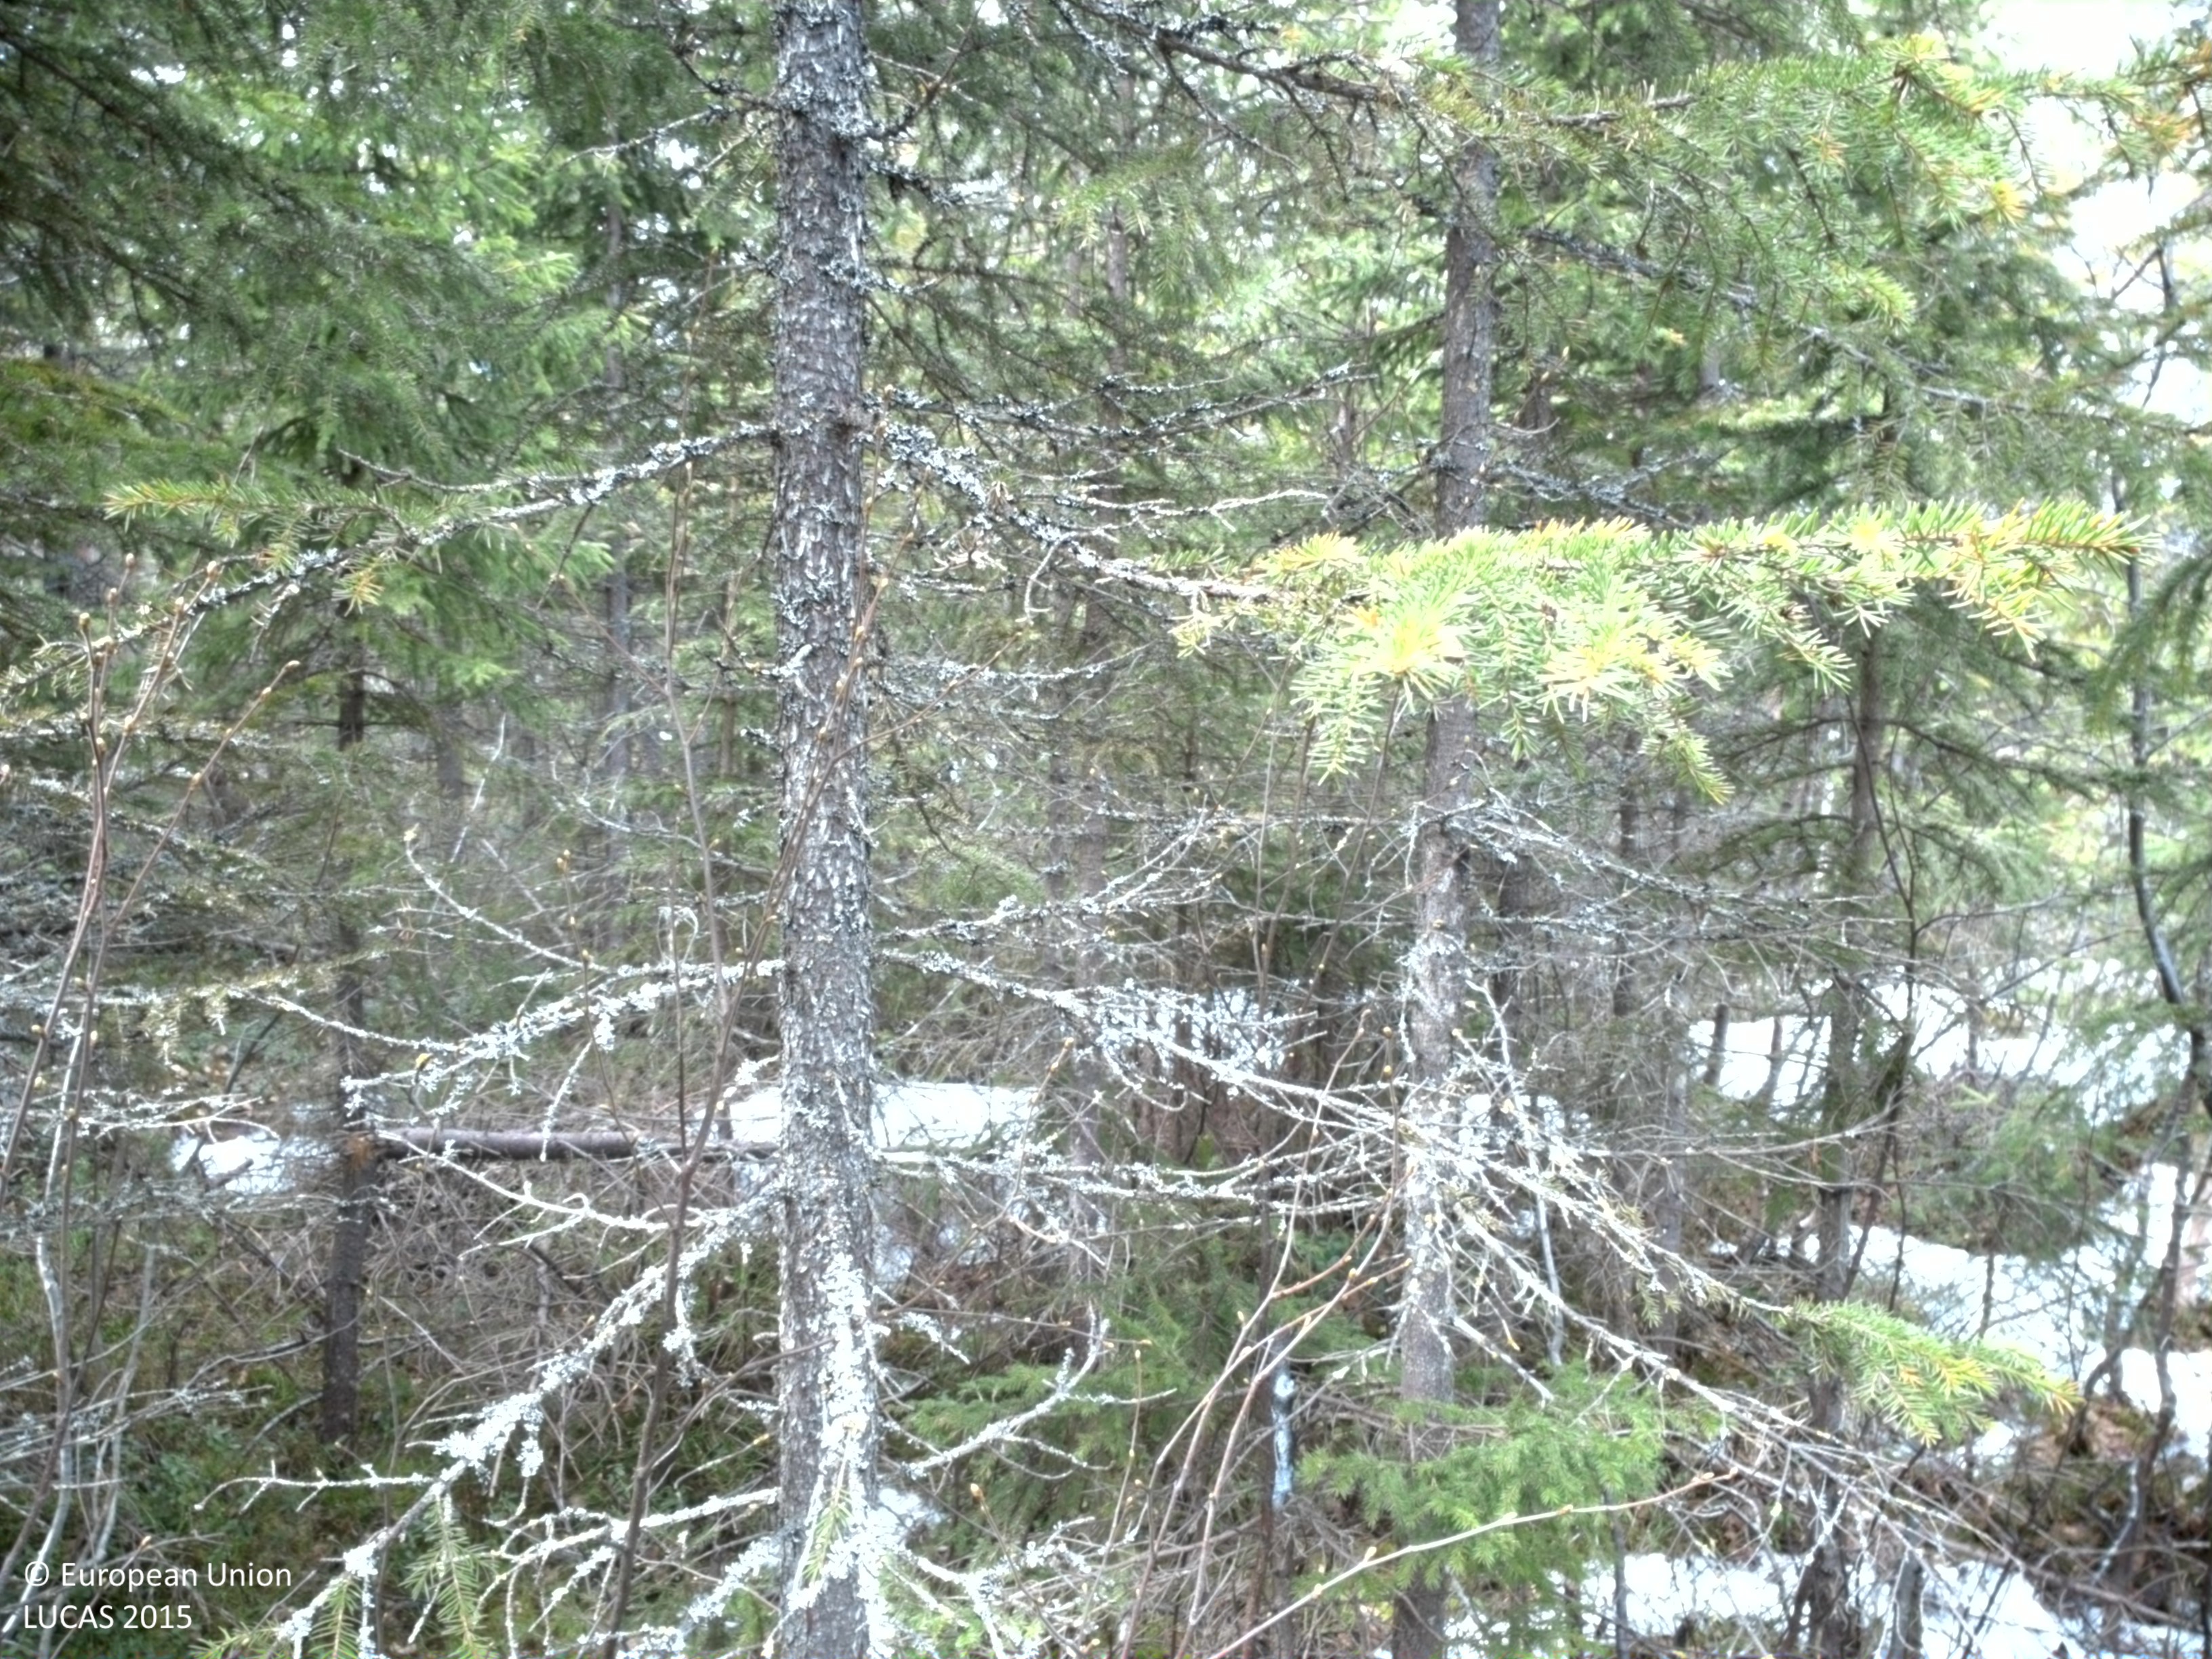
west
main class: Woodland
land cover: Other coniferous woodland
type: boreal forest
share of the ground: > 75 %
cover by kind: coniferous forest trees 75 %, shrubs 20 %, broadleaved forest trees 5 %
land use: Forestry
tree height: > 5 m
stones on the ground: < 10 %
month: May
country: SE
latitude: 66.1662
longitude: 23.8100
